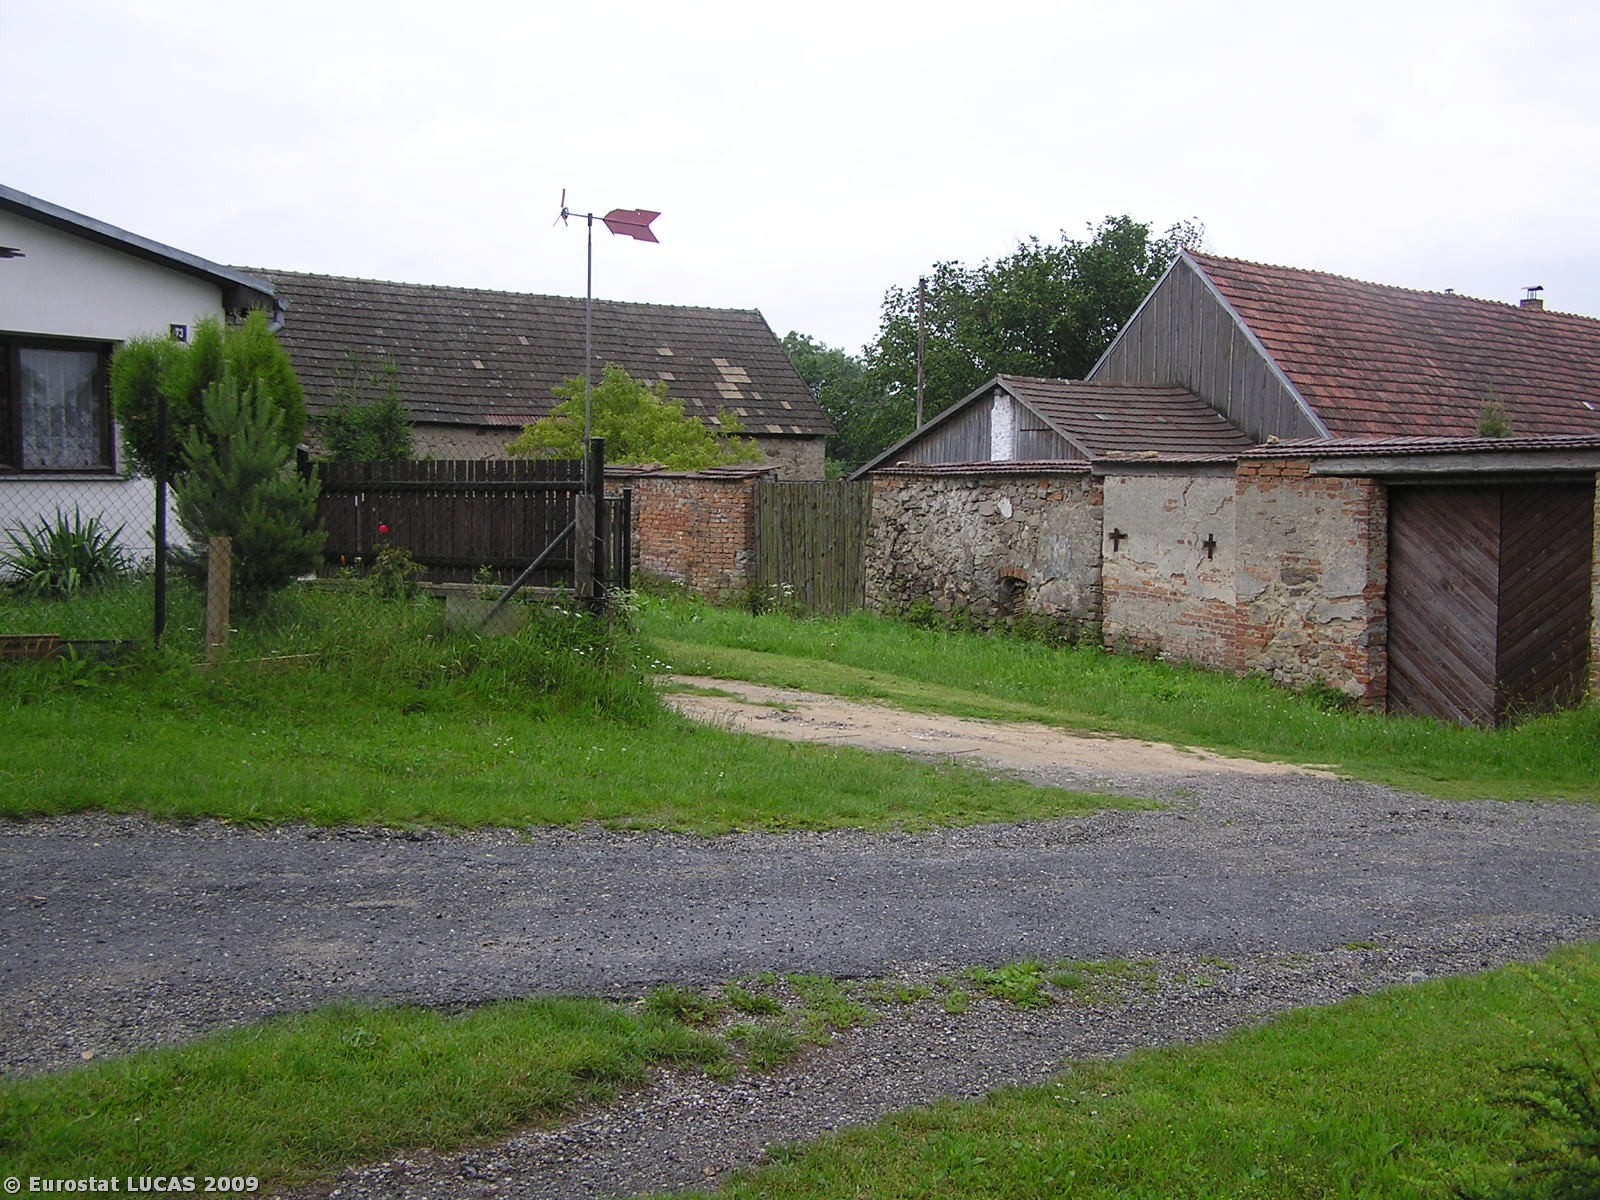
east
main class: Grassland
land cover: Grassland with sparse tree/shrub cover
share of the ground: > 75 %
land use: Residential
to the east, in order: Grassland with sparse tree/shrub cover; Tracks; Artificial constructions in urban areas; Paved roads, cycling and walking lanes; Ditches and canals; Lines of trees; Grassland without tree/shrub cover
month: June
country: CZ
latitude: 49.1936
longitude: 14.9559
